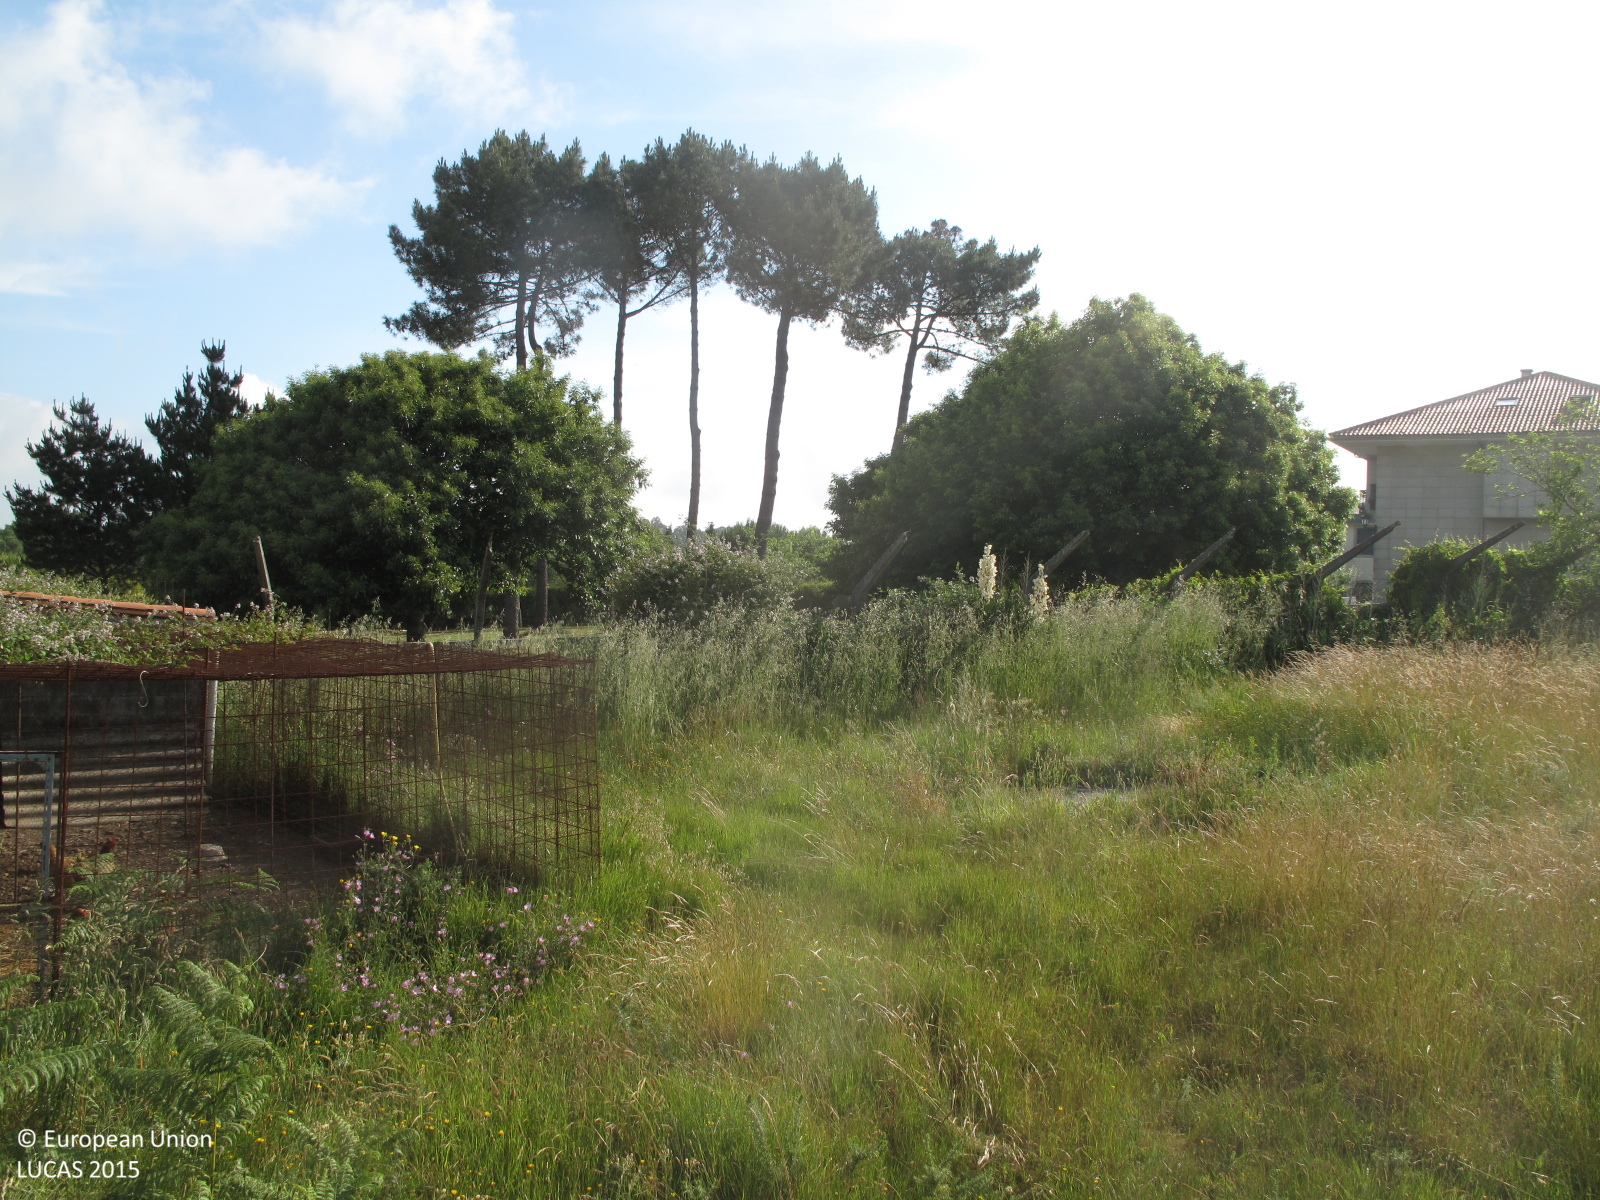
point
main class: Woodland
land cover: Broadleaved woodland
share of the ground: 10 - 25 %
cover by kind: herbaceous plants 85 %, broadleaved forest trees 15 %
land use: Residential
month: June
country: ES
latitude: 42.8937
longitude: -8.4838
